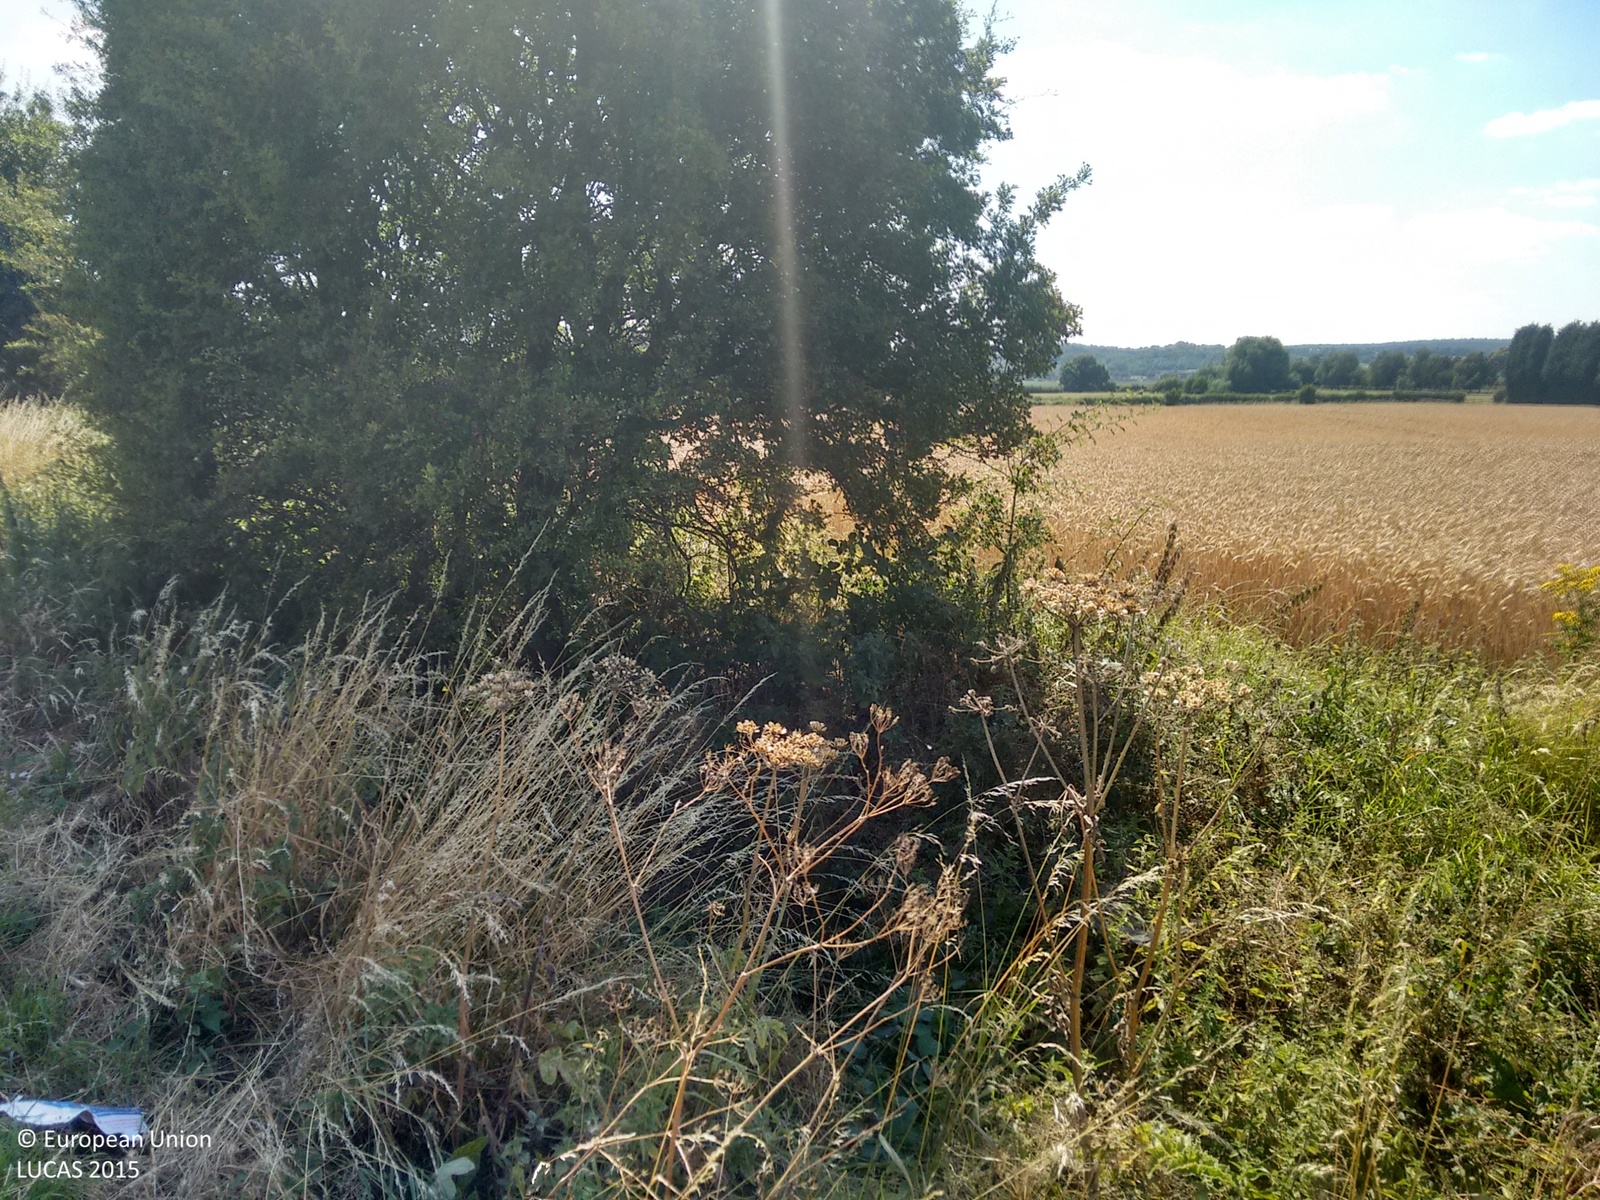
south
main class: Cropland
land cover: Common wheat
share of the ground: > 75 %
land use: Agriculture (excluding fallow land and kitchen gardens)
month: August
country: GB
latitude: 52.5629
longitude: -1.4834
